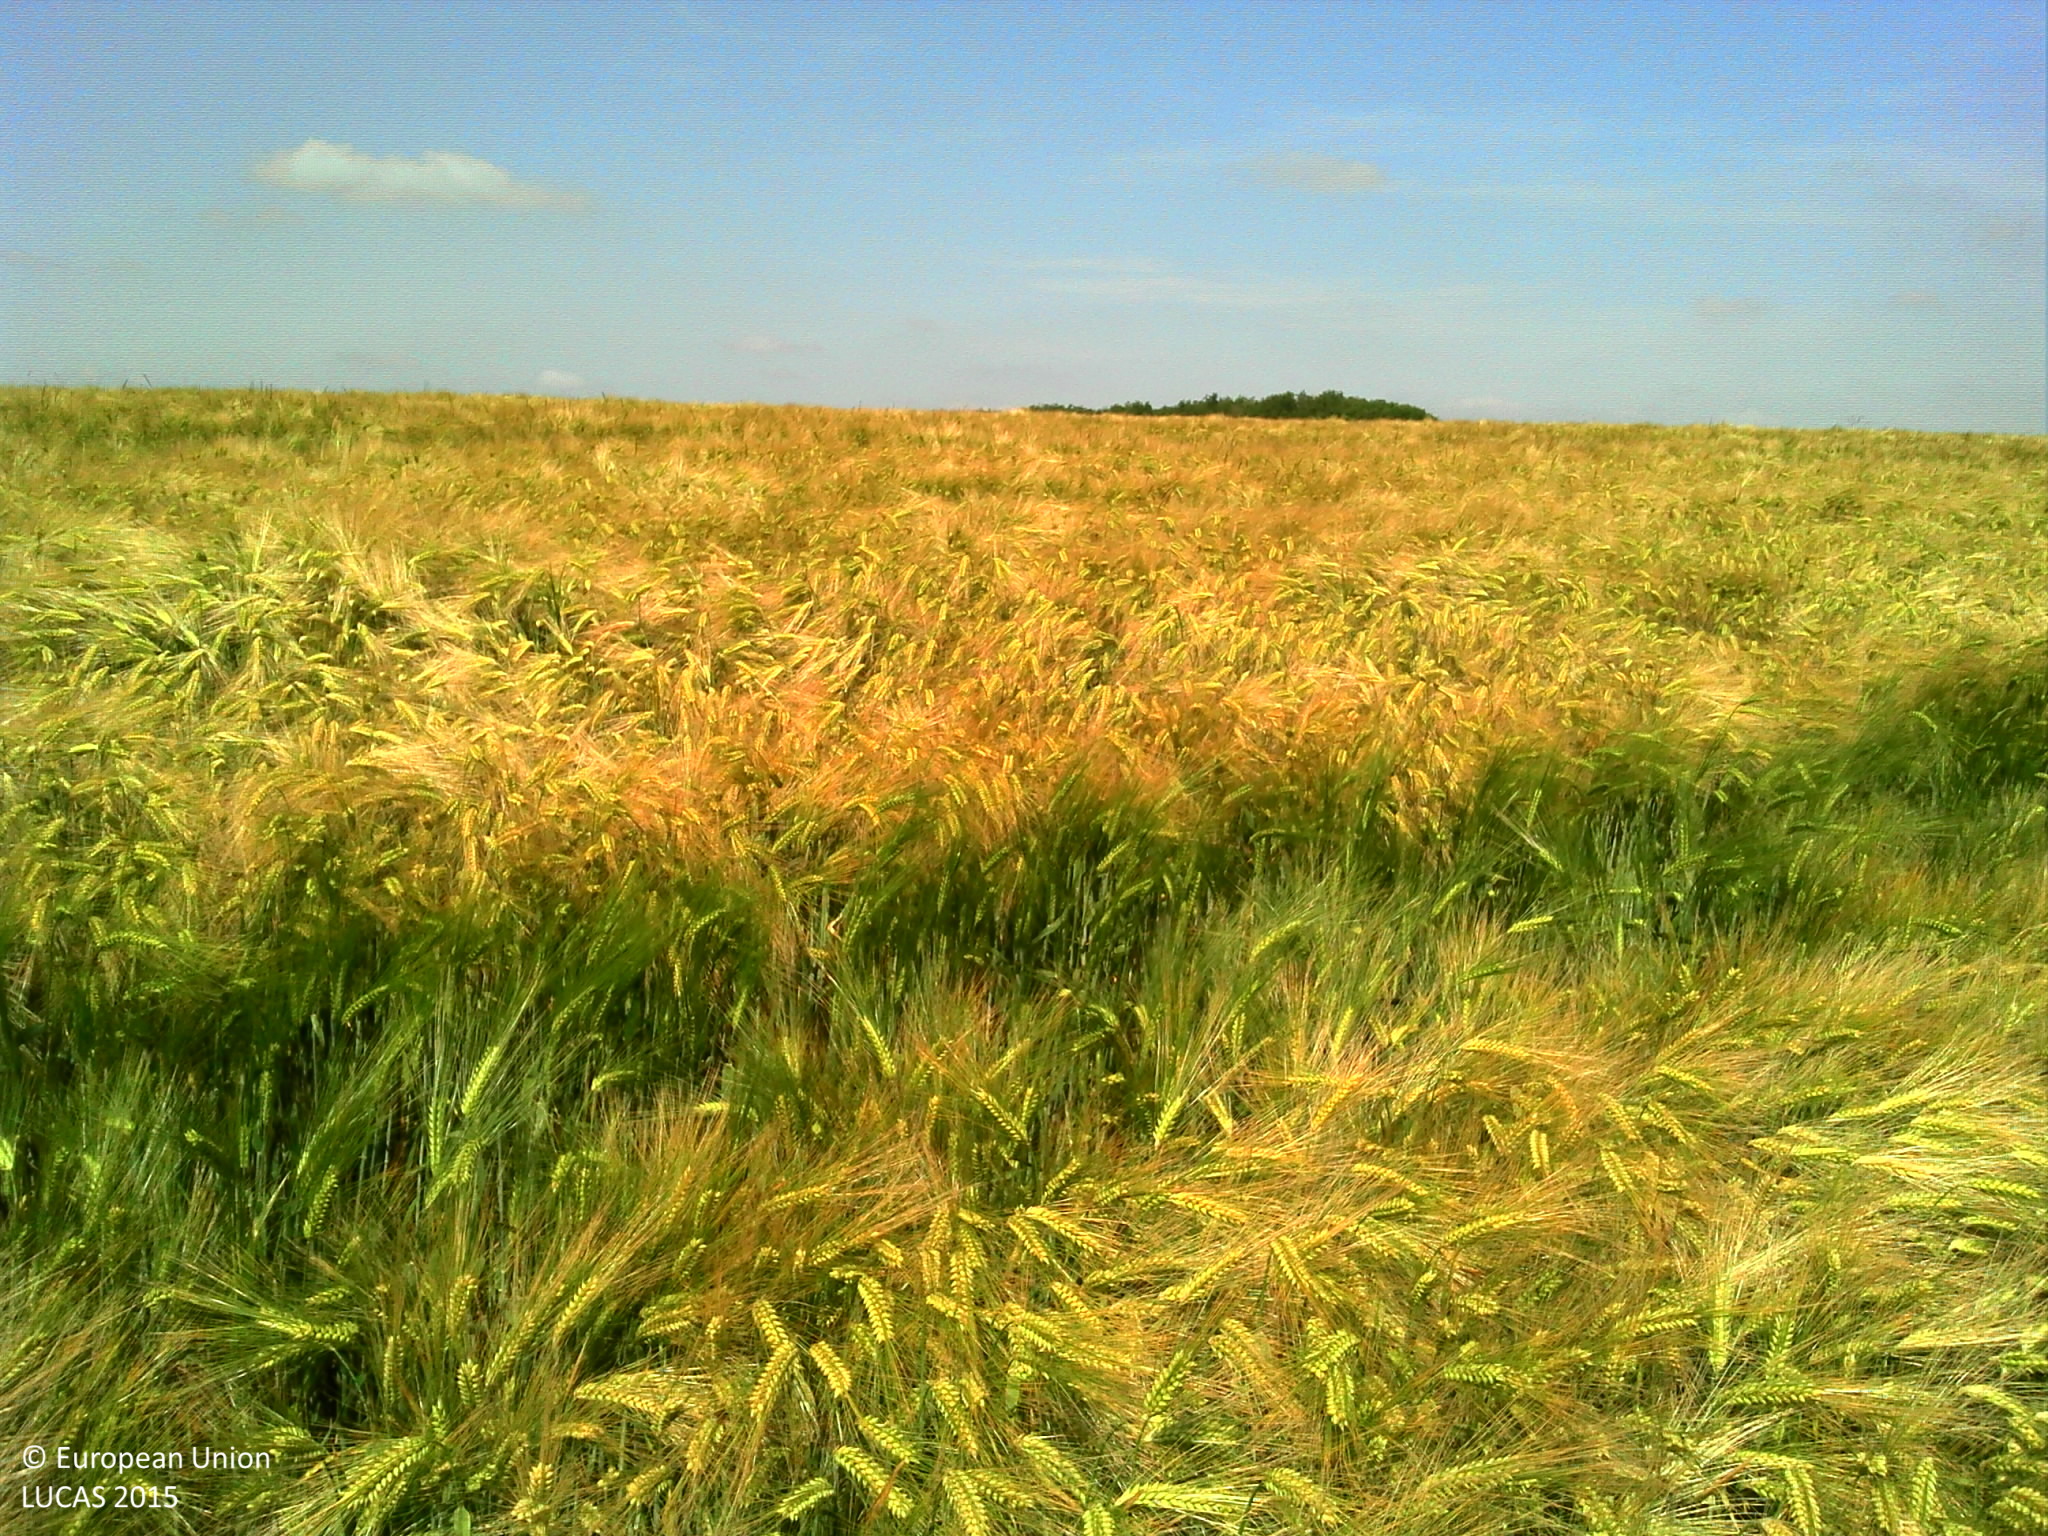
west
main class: Cropland
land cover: Barley
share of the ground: > 75 %
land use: Agriculture (excluding fallow land and kitchen gardens)
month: June
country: FR
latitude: 50.4416
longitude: 2.4821
